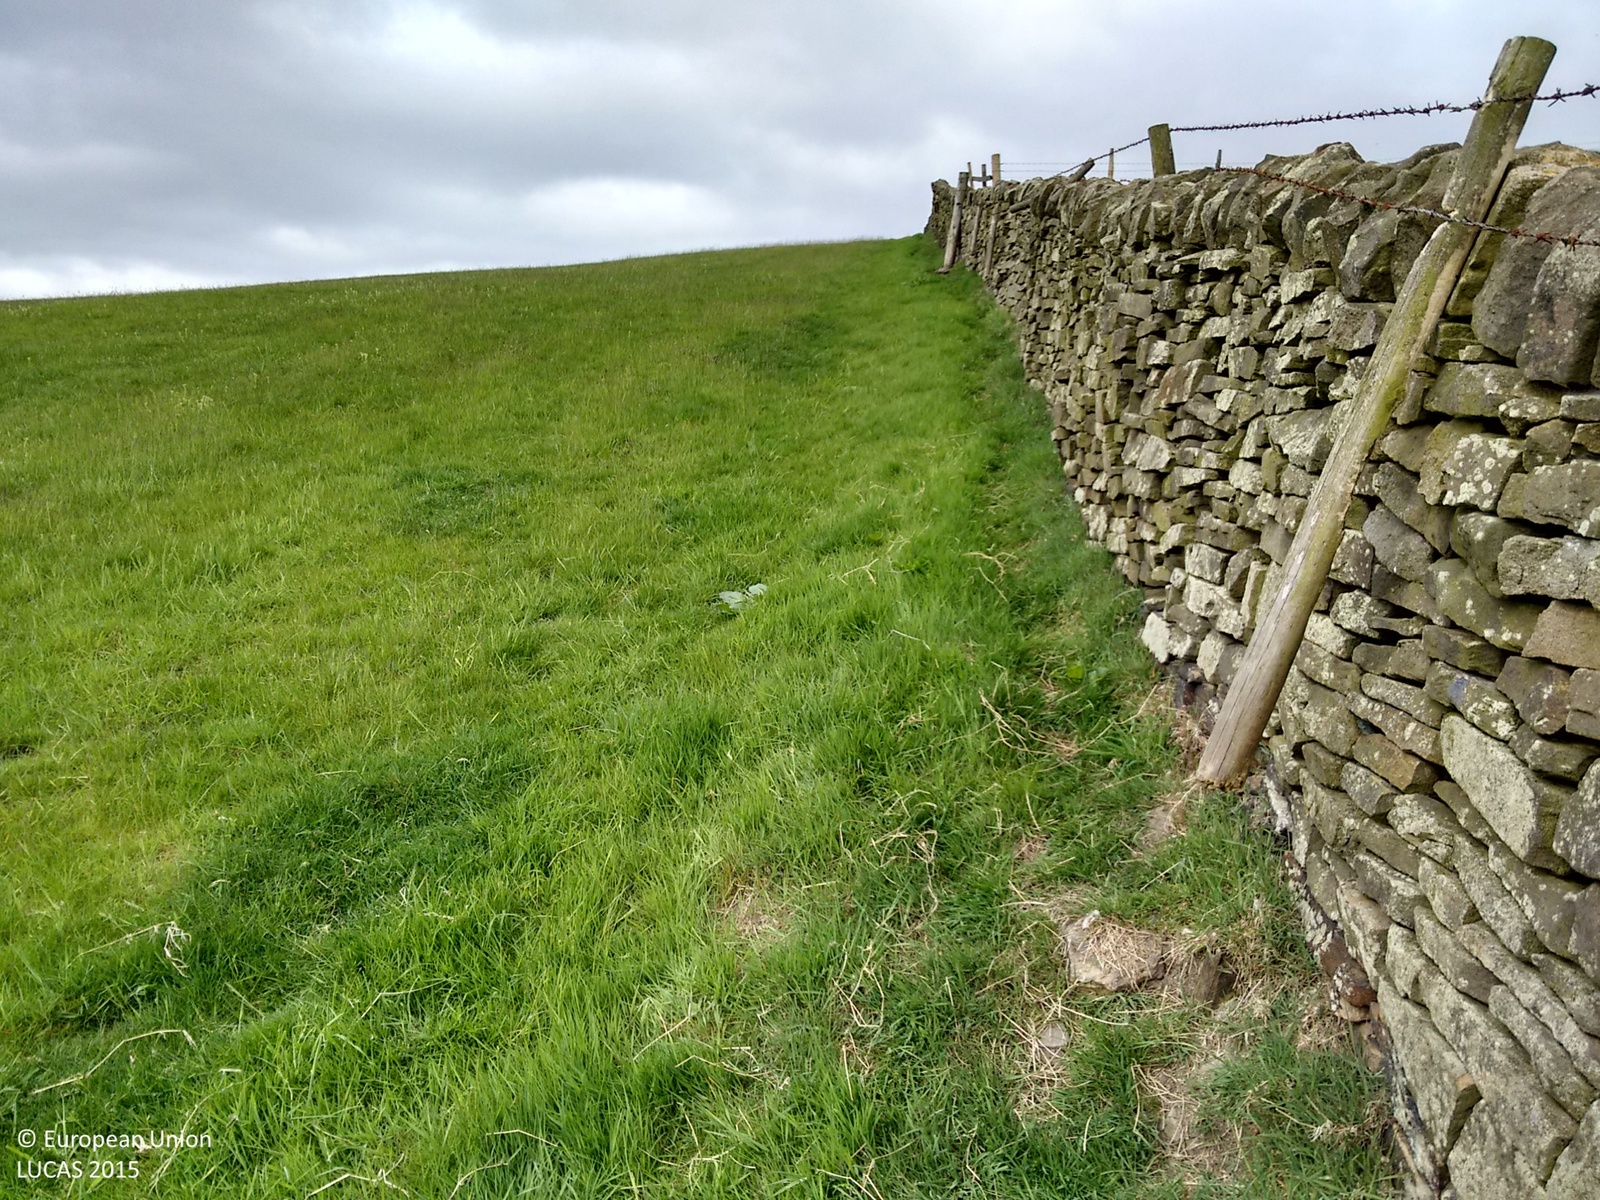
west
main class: Grassland
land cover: Grassland without tree/shrub cover
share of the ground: > 75 %
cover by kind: herbaceous plants 100 %
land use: Agriculture (excluding fallow land and kitchen gardens)
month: May
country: GB
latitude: 53.4038
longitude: -1.6187
